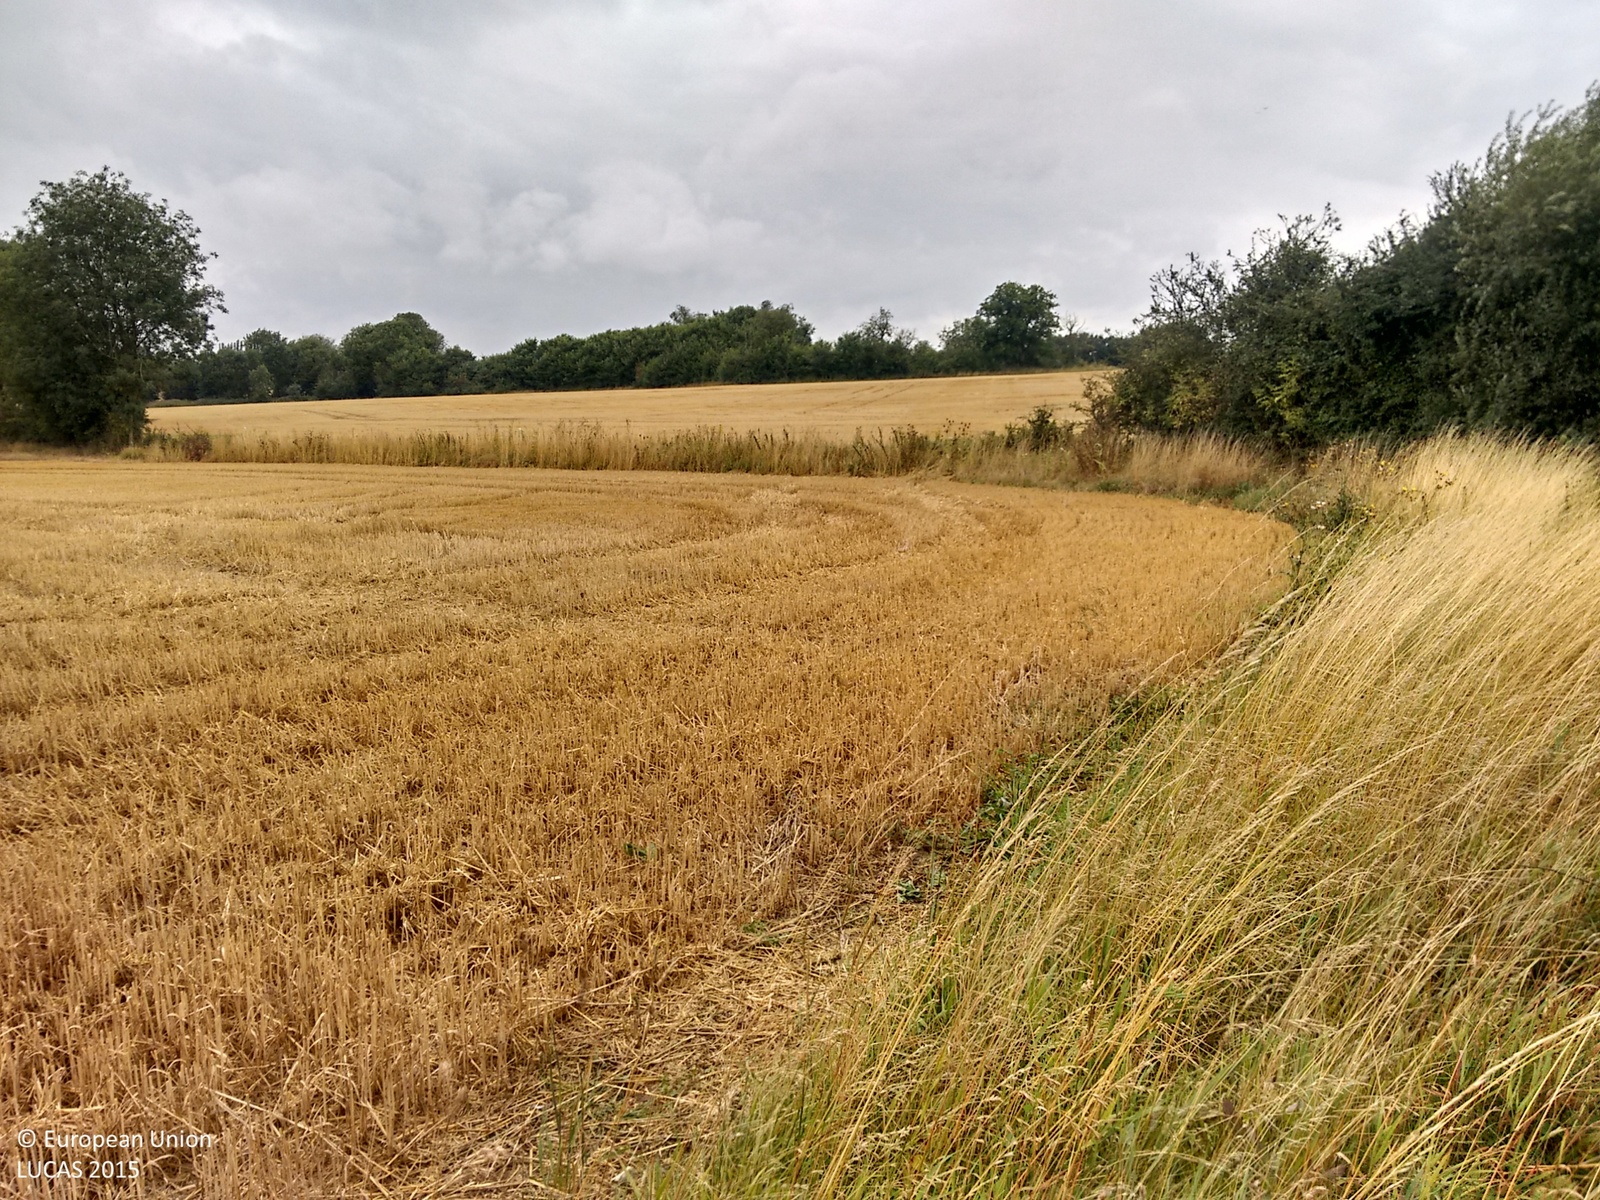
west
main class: Woodland
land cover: Other mixed woodland
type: mesophytic deciduous forest
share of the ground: > 75 %
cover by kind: broadleaved forest trees 70 %, coniferous forest trees 25 %, shrubs 5 %
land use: Semi-natural and natural areas not in use
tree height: > 5 m
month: August
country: GB
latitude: 52.1242
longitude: 0.5222
